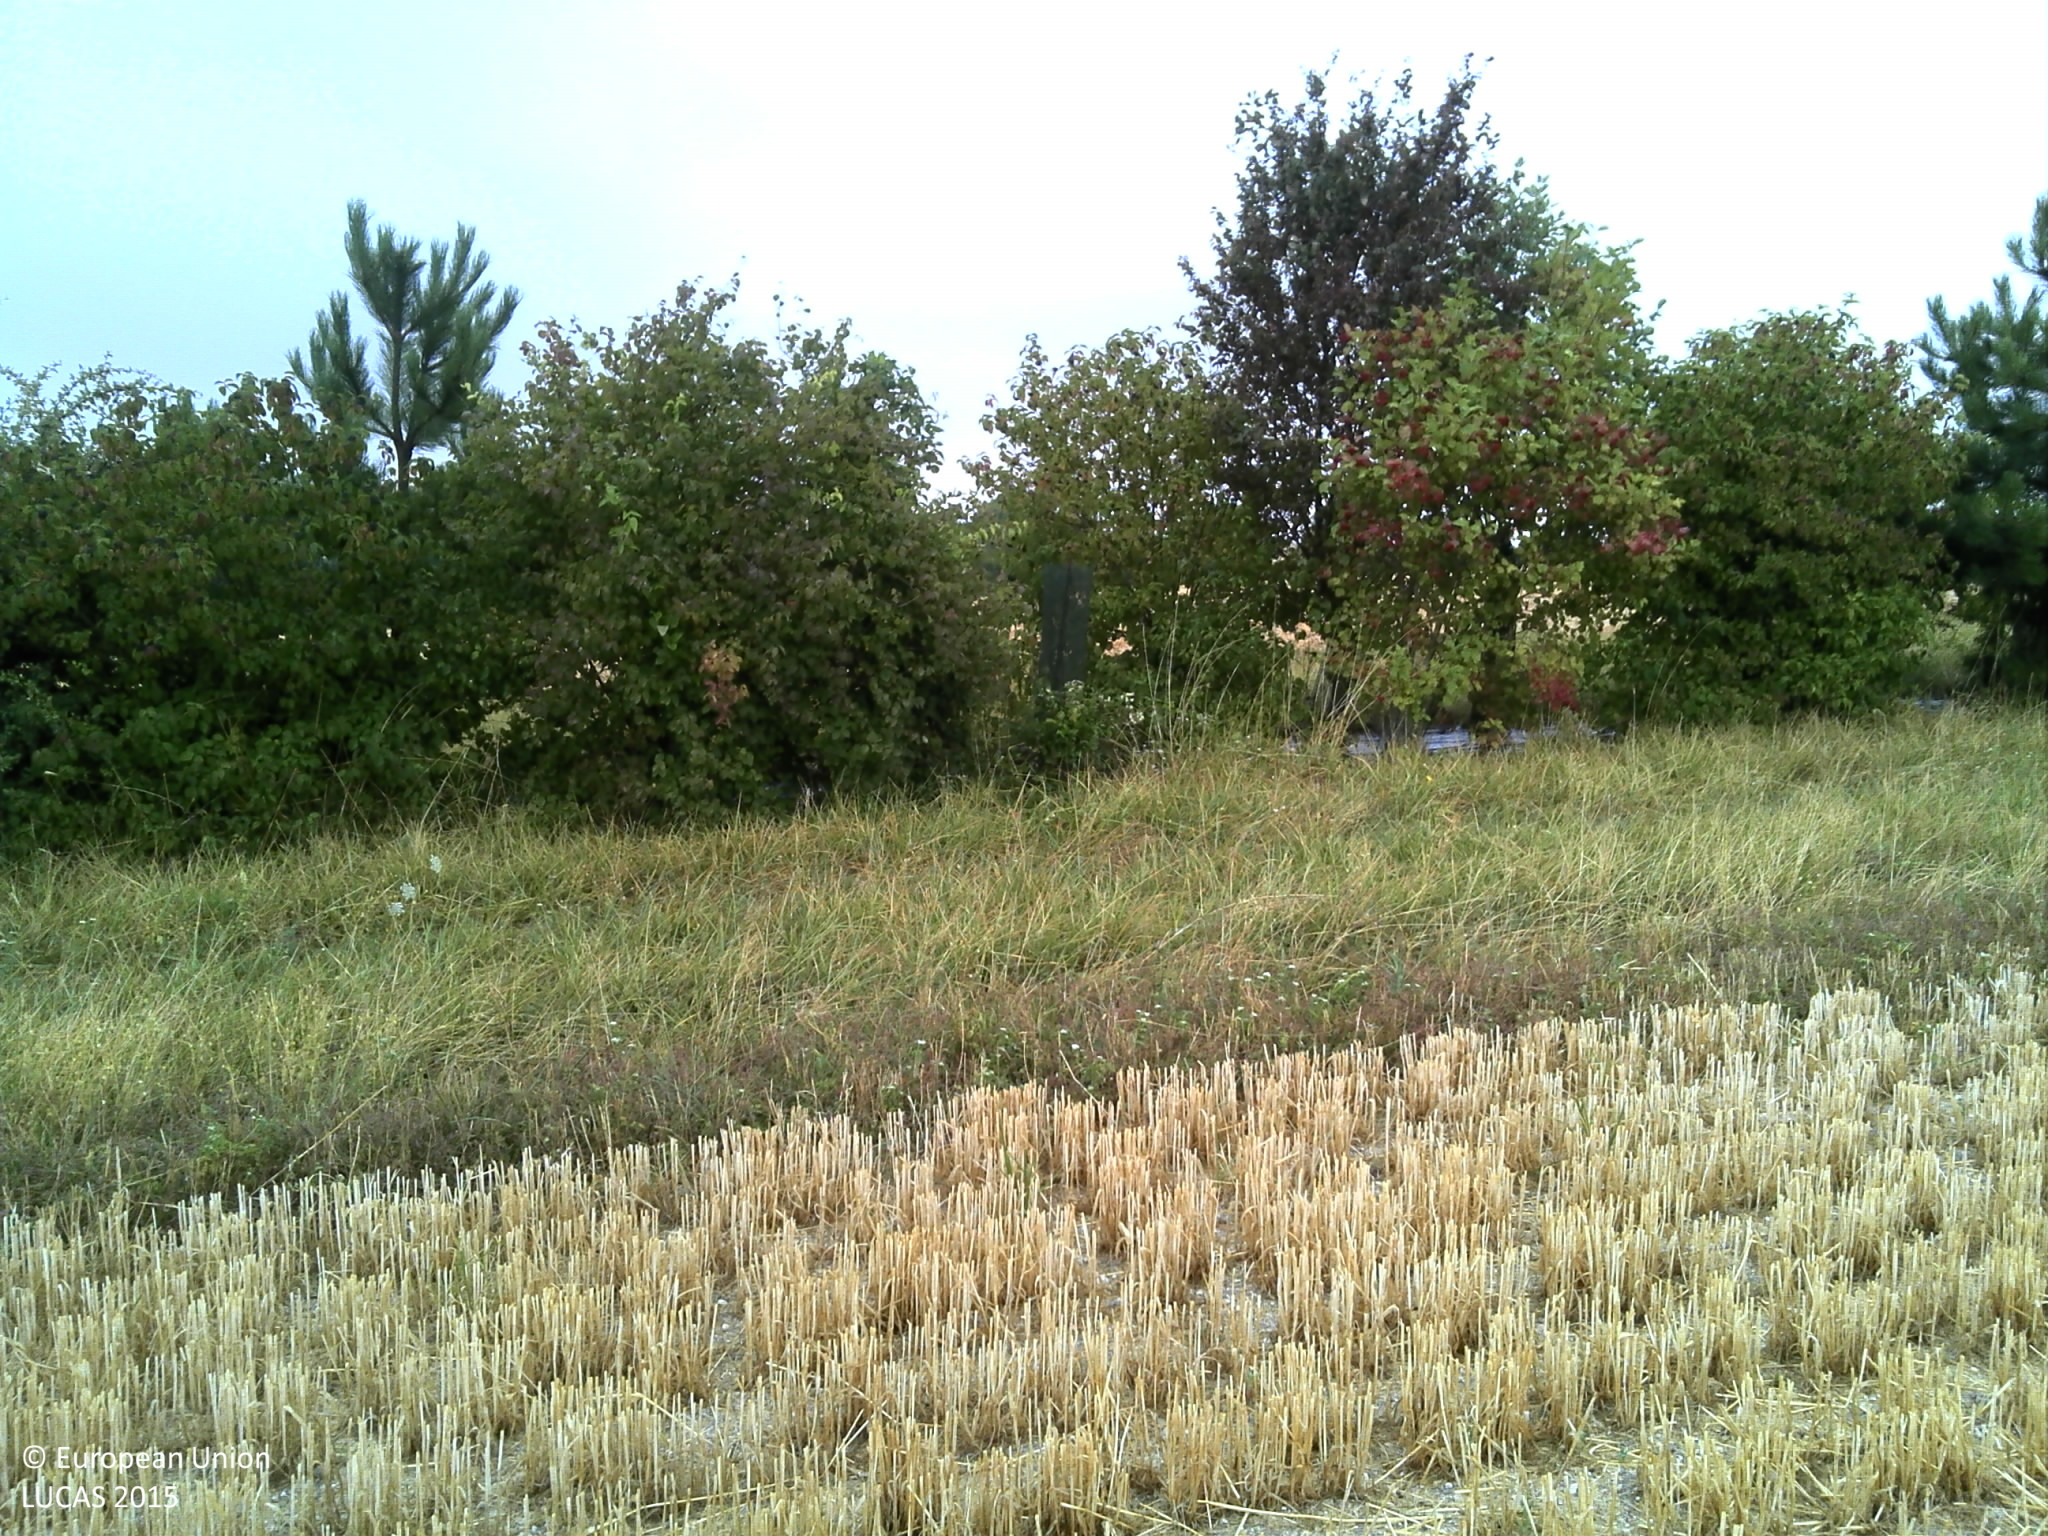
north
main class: Cropland
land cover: Barley
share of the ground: > 75 %
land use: Agriculture (excluding fallow land and kitchen gardens)
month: July
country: FR
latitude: 48.8352
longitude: 4.6976
